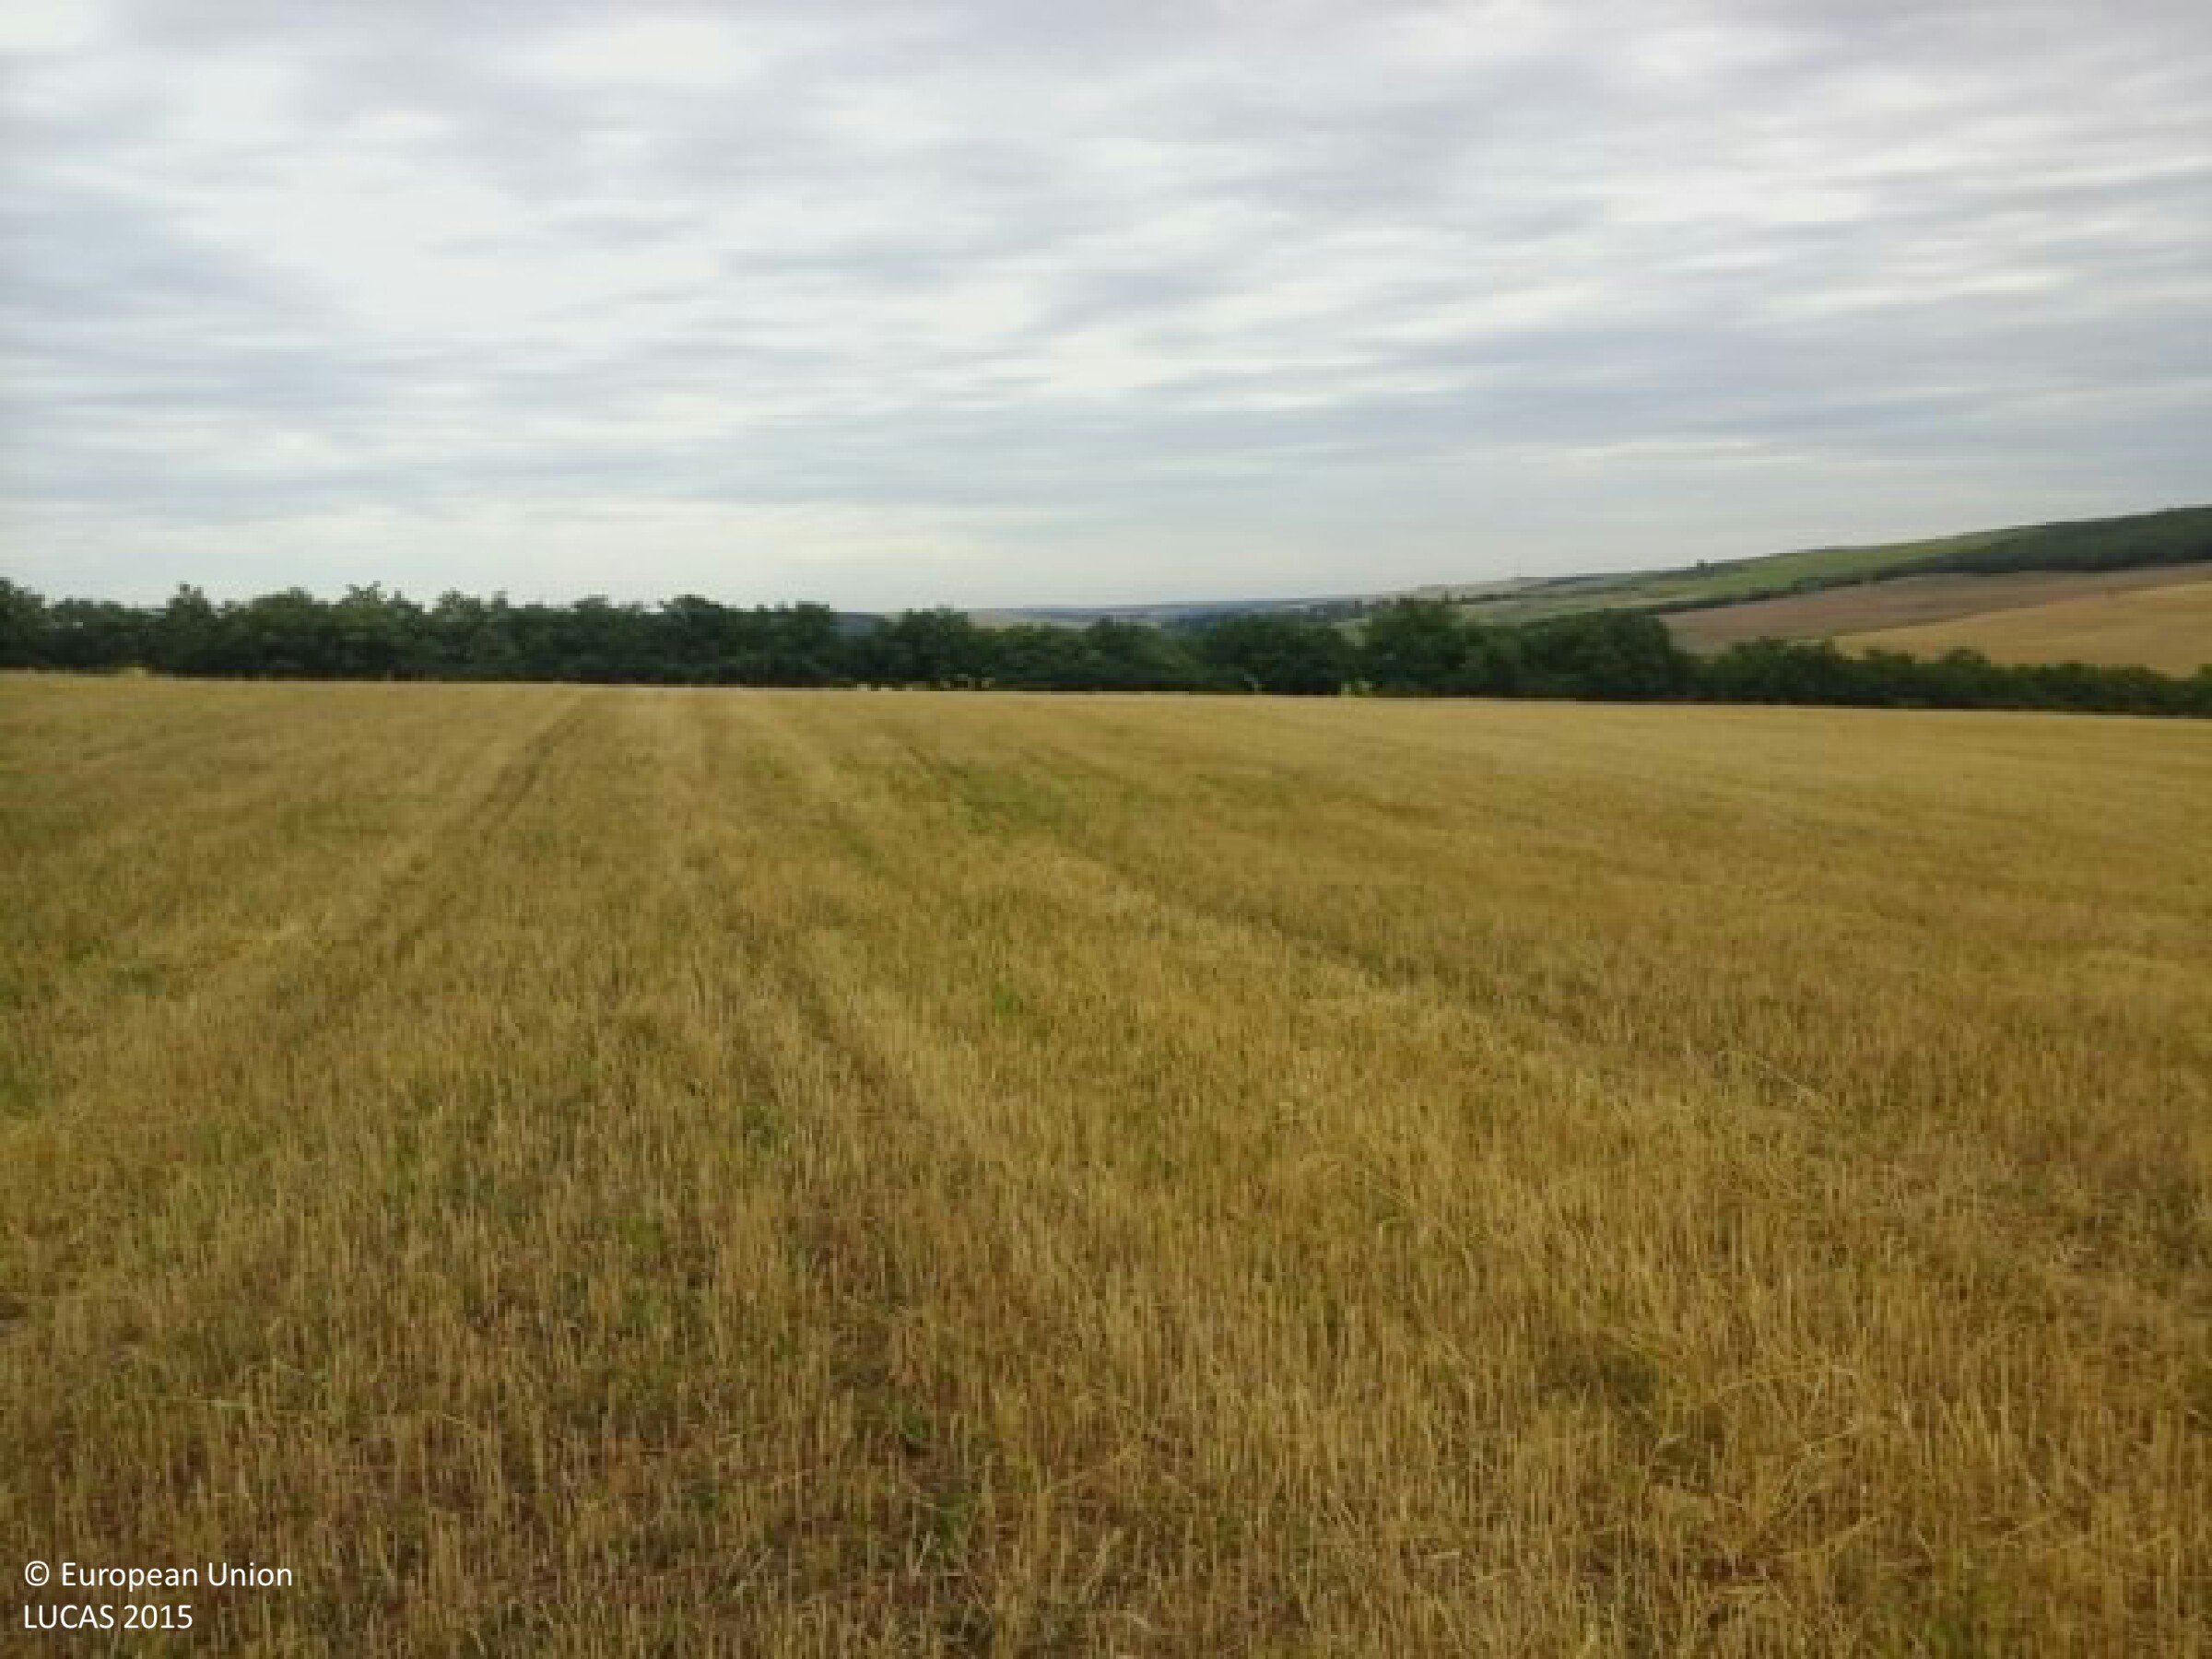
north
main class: Cropland
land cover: Common wheat
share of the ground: 50 - 75 %
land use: Agriculture (excluding fallow land and kitchen gardens)
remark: Harvested field
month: July
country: HU
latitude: 47.7621
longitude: 19.4545
